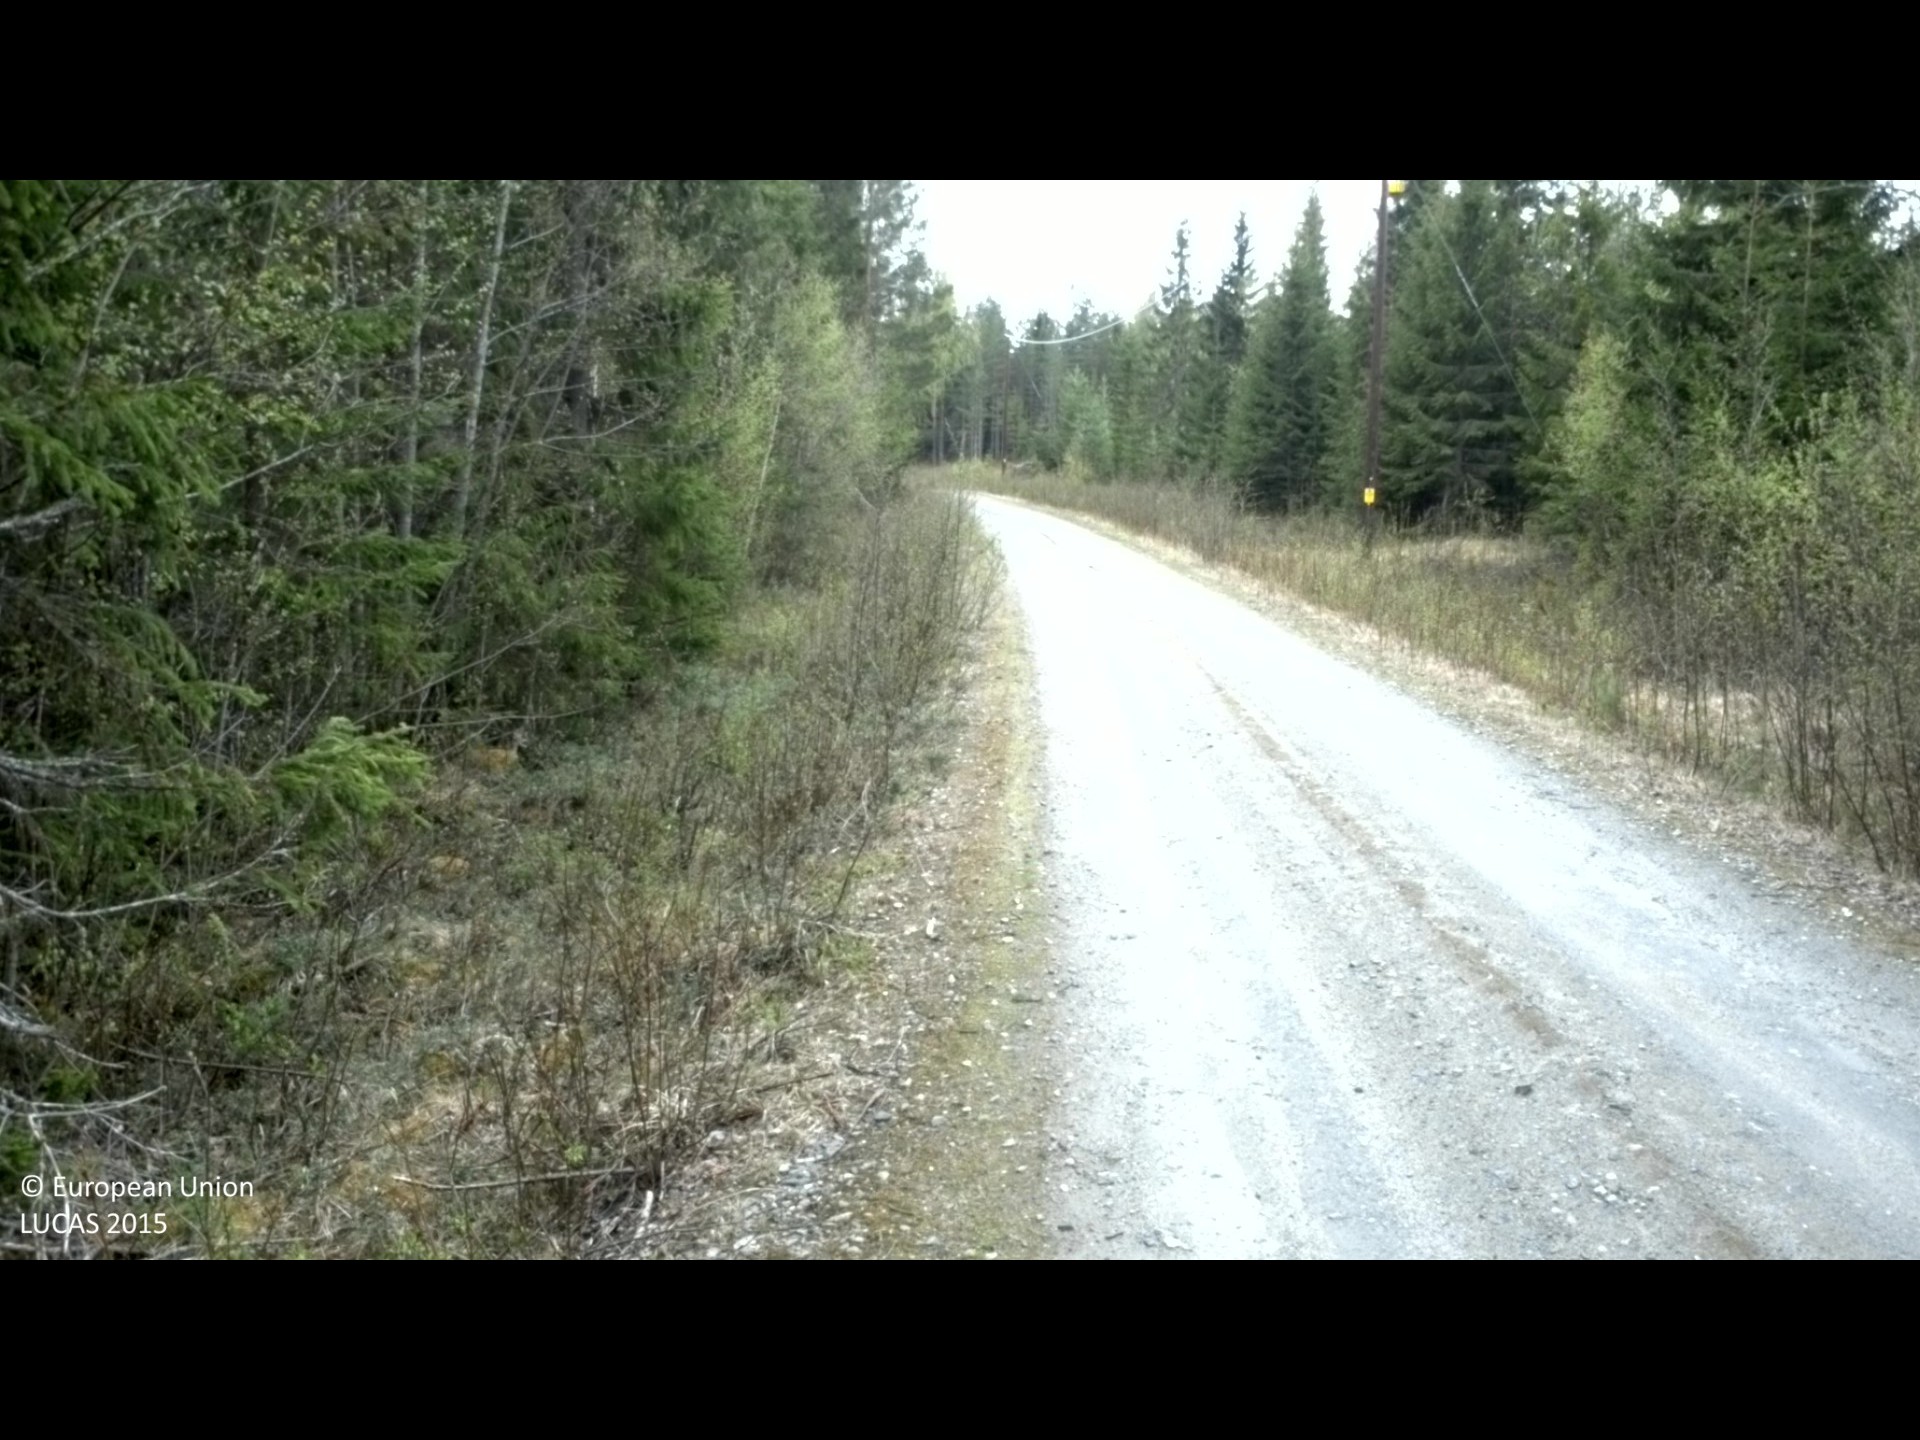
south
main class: Woodland
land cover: Spruce dominated coniferous woodland
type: boreal forest
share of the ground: > 75 %
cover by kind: coniferous forest trees 90 %, shrubs 10 %
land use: Forestry
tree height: > 5 m
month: May
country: SE
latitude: 63.0846
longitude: 17.3622
